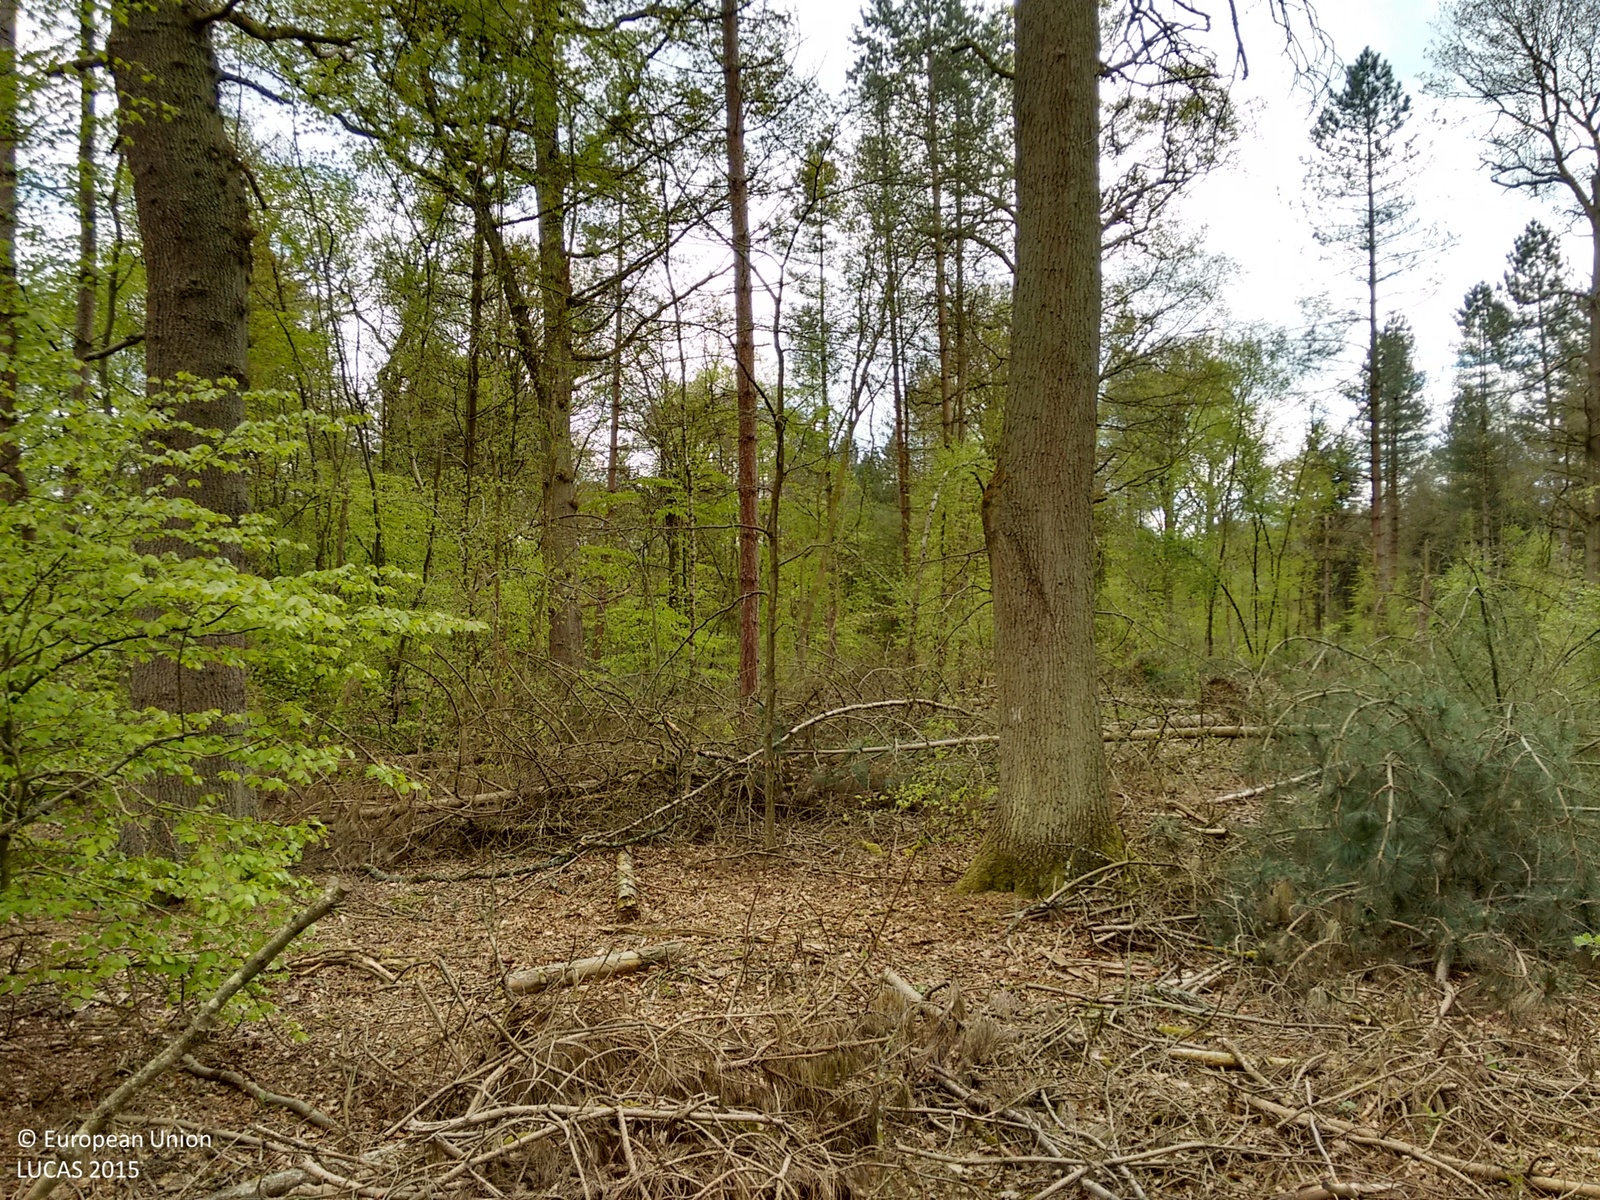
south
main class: Woodland
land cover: Pine dominated mixed woodland
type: mesophytic deciduous forest
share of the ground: 50 - 75 %
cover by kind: coniferous forest trees 60 %, broadleaved forest trees 30 %, shrubs 10 %
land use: Forestry
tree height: > 5 m
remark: Clear cut
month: April
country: GB
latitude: 51.6597
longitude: -0.6656
